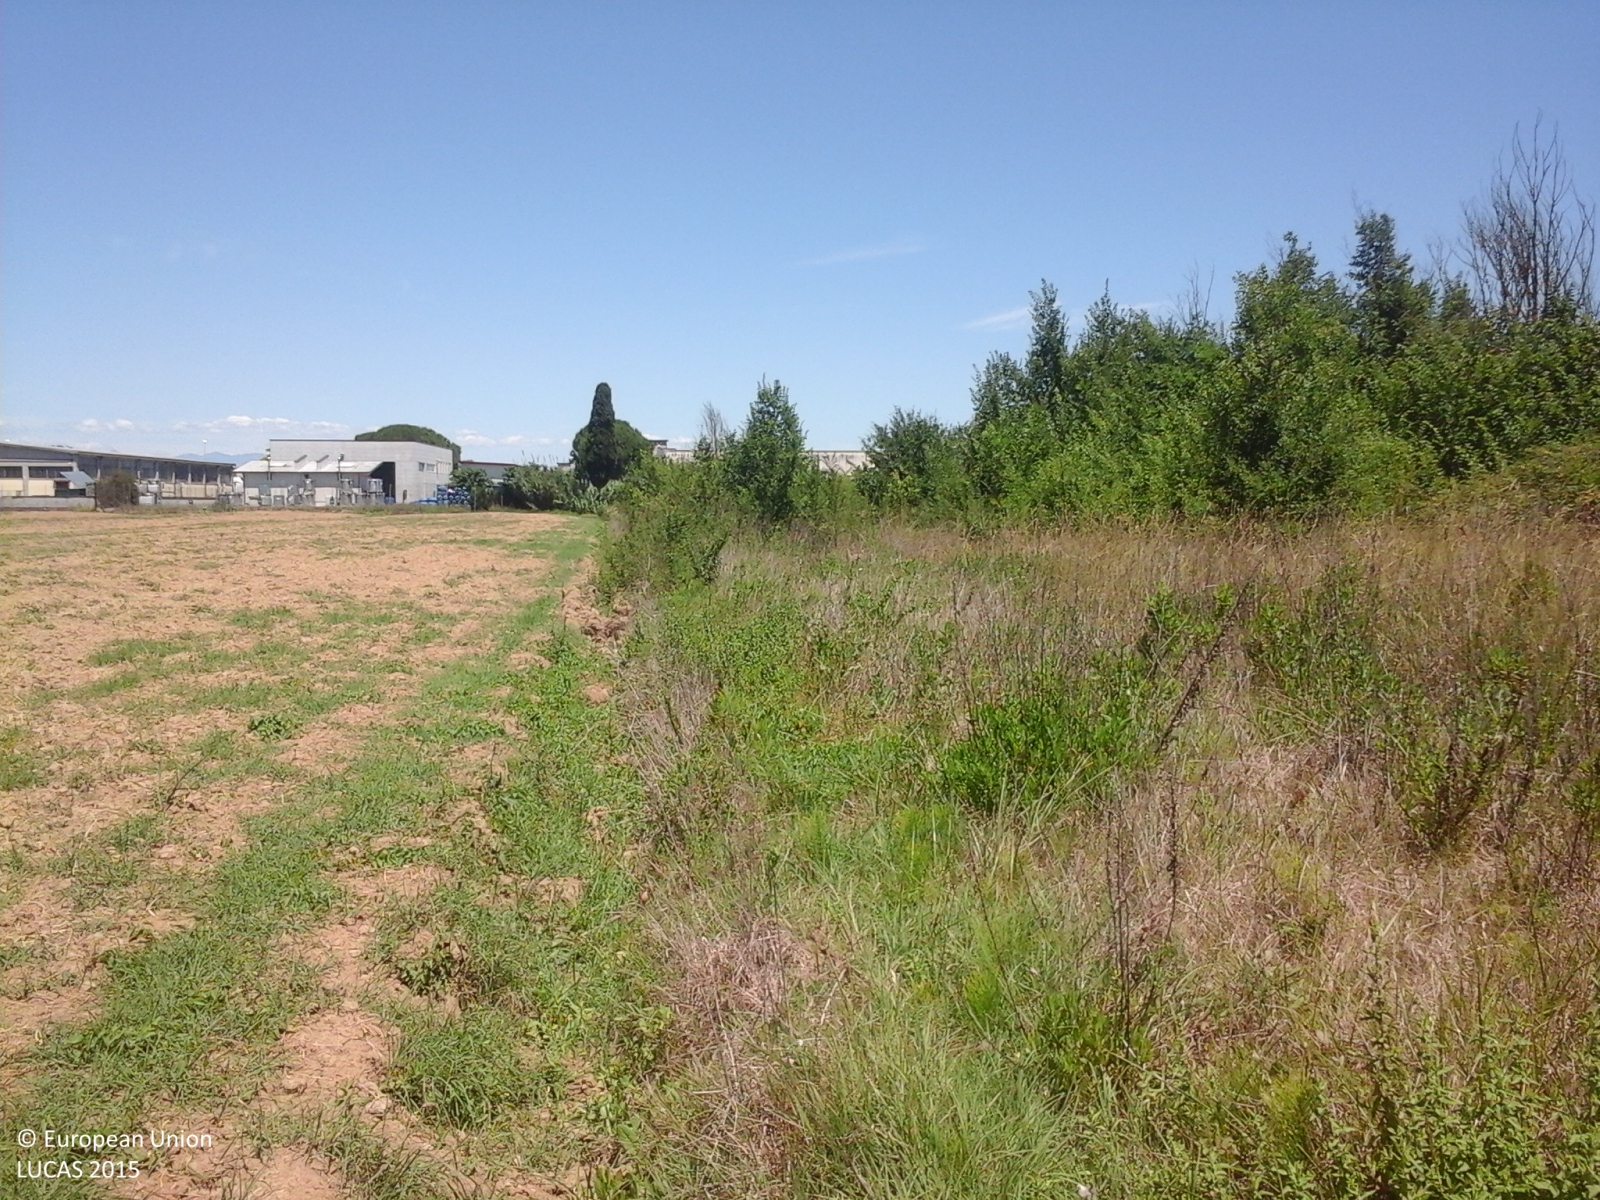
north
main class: Grassland
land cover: Grassland with sparse tree/shrub cover
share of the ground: 50 - 75 %
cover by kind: herbaceous plants 85 %, shrubs 10 %, broadleaved forest trees 5 %
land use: Semi-natural and natural areas not in use
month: June
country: IT
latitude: 43.6091
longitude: 10.6054
